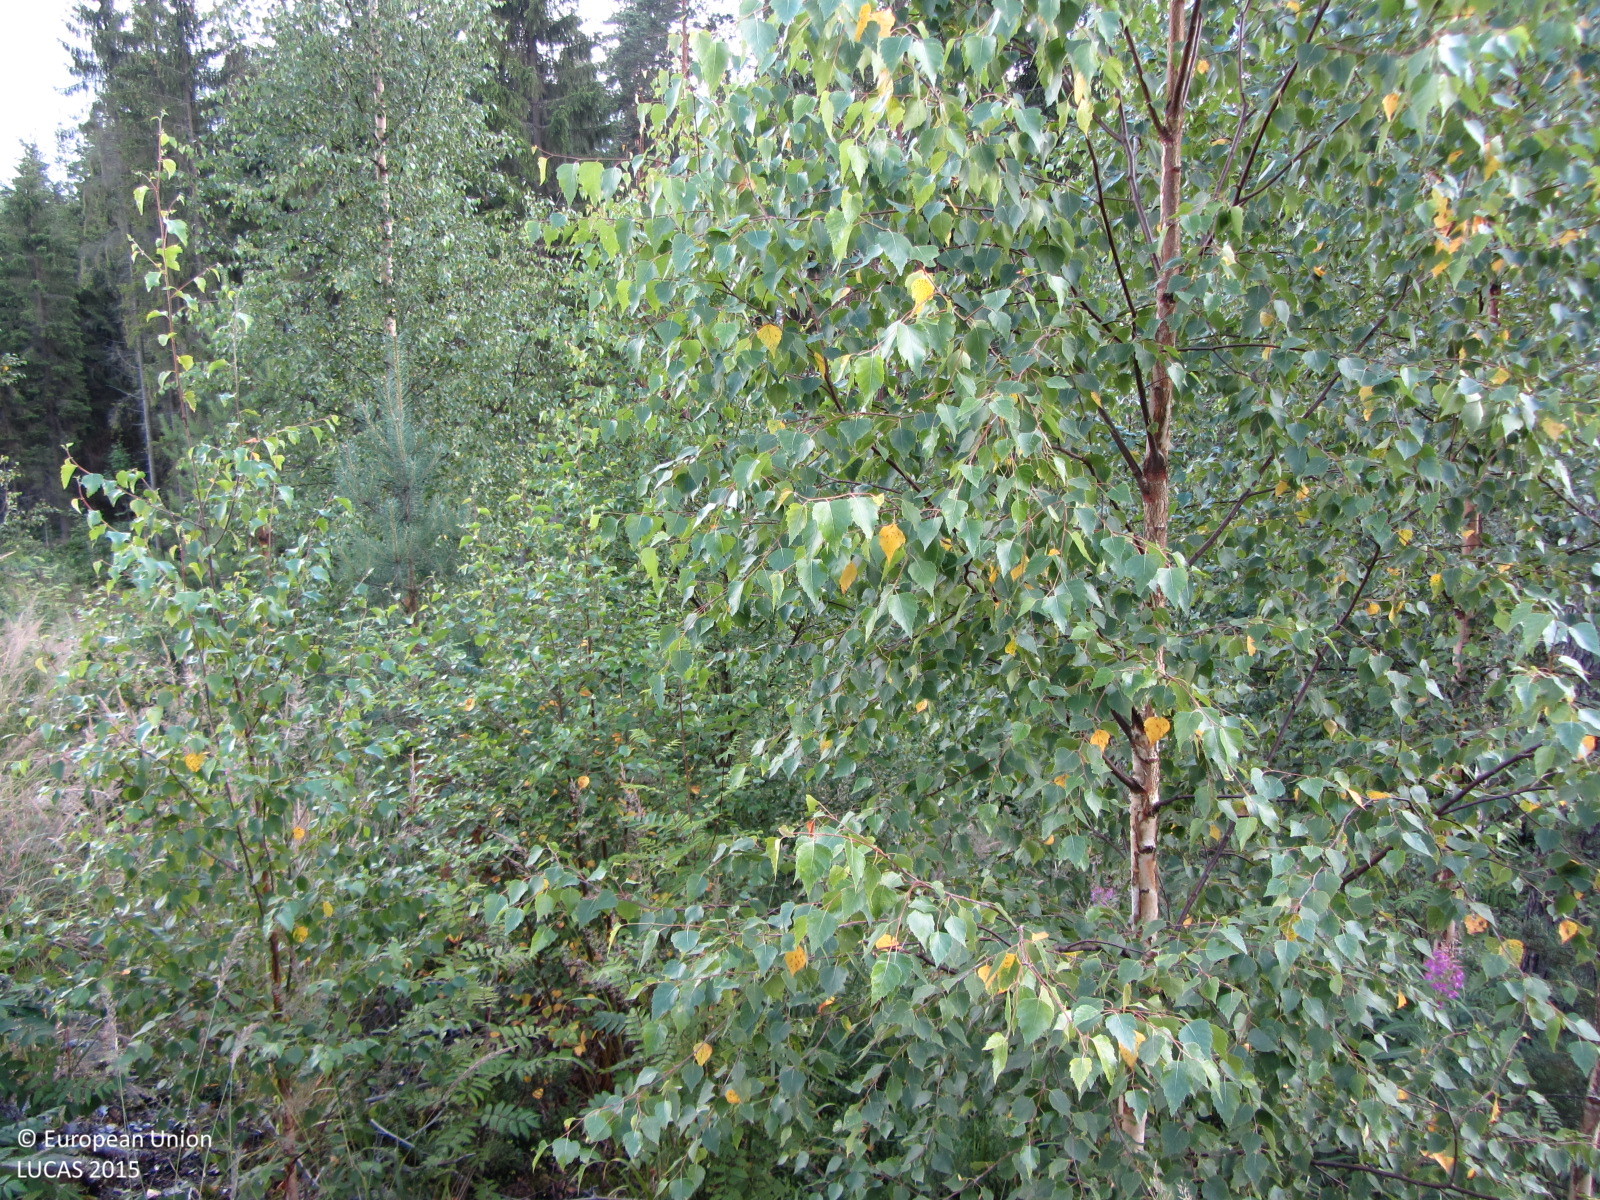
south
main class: Woodland
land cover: Pine dominated mixed woodland
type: boreal forest
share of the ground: 50 - 75 %
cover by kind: broadleaved forest trees 40 %, herbaceous plants 25 %, coniferous forest trees 20 %, lichens and mosses 10 %, consolidated bare surface 5 %
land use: Forestry
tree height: < 5 m
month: July
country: FI
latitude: 60.7283
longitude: 24.6846
